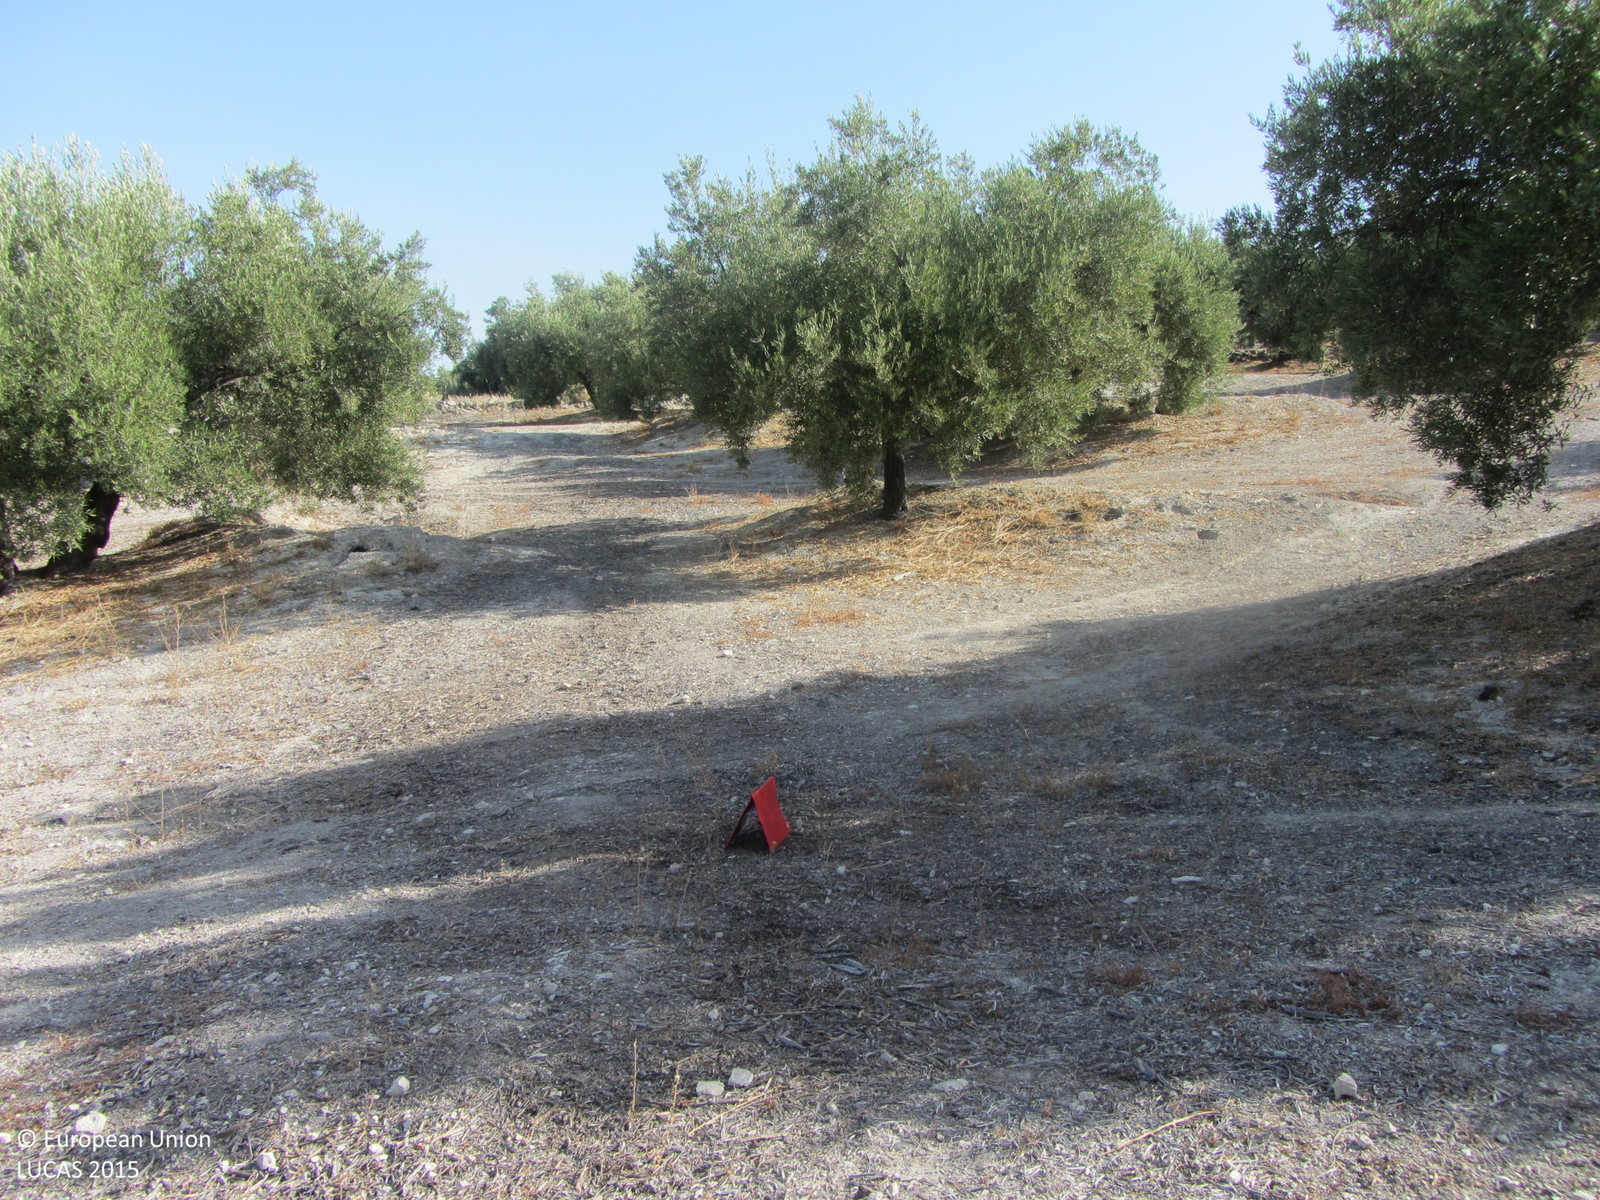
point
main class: Cropland
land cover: Olive groves
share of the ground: 25 - 50 %
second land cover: Other bare soil
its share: > 75 %
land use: Agriculture (excluding fallow land and kitchen gardens)
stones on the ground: < 10 %
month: July
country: ES
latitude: 37.6771
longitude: -4.1420
